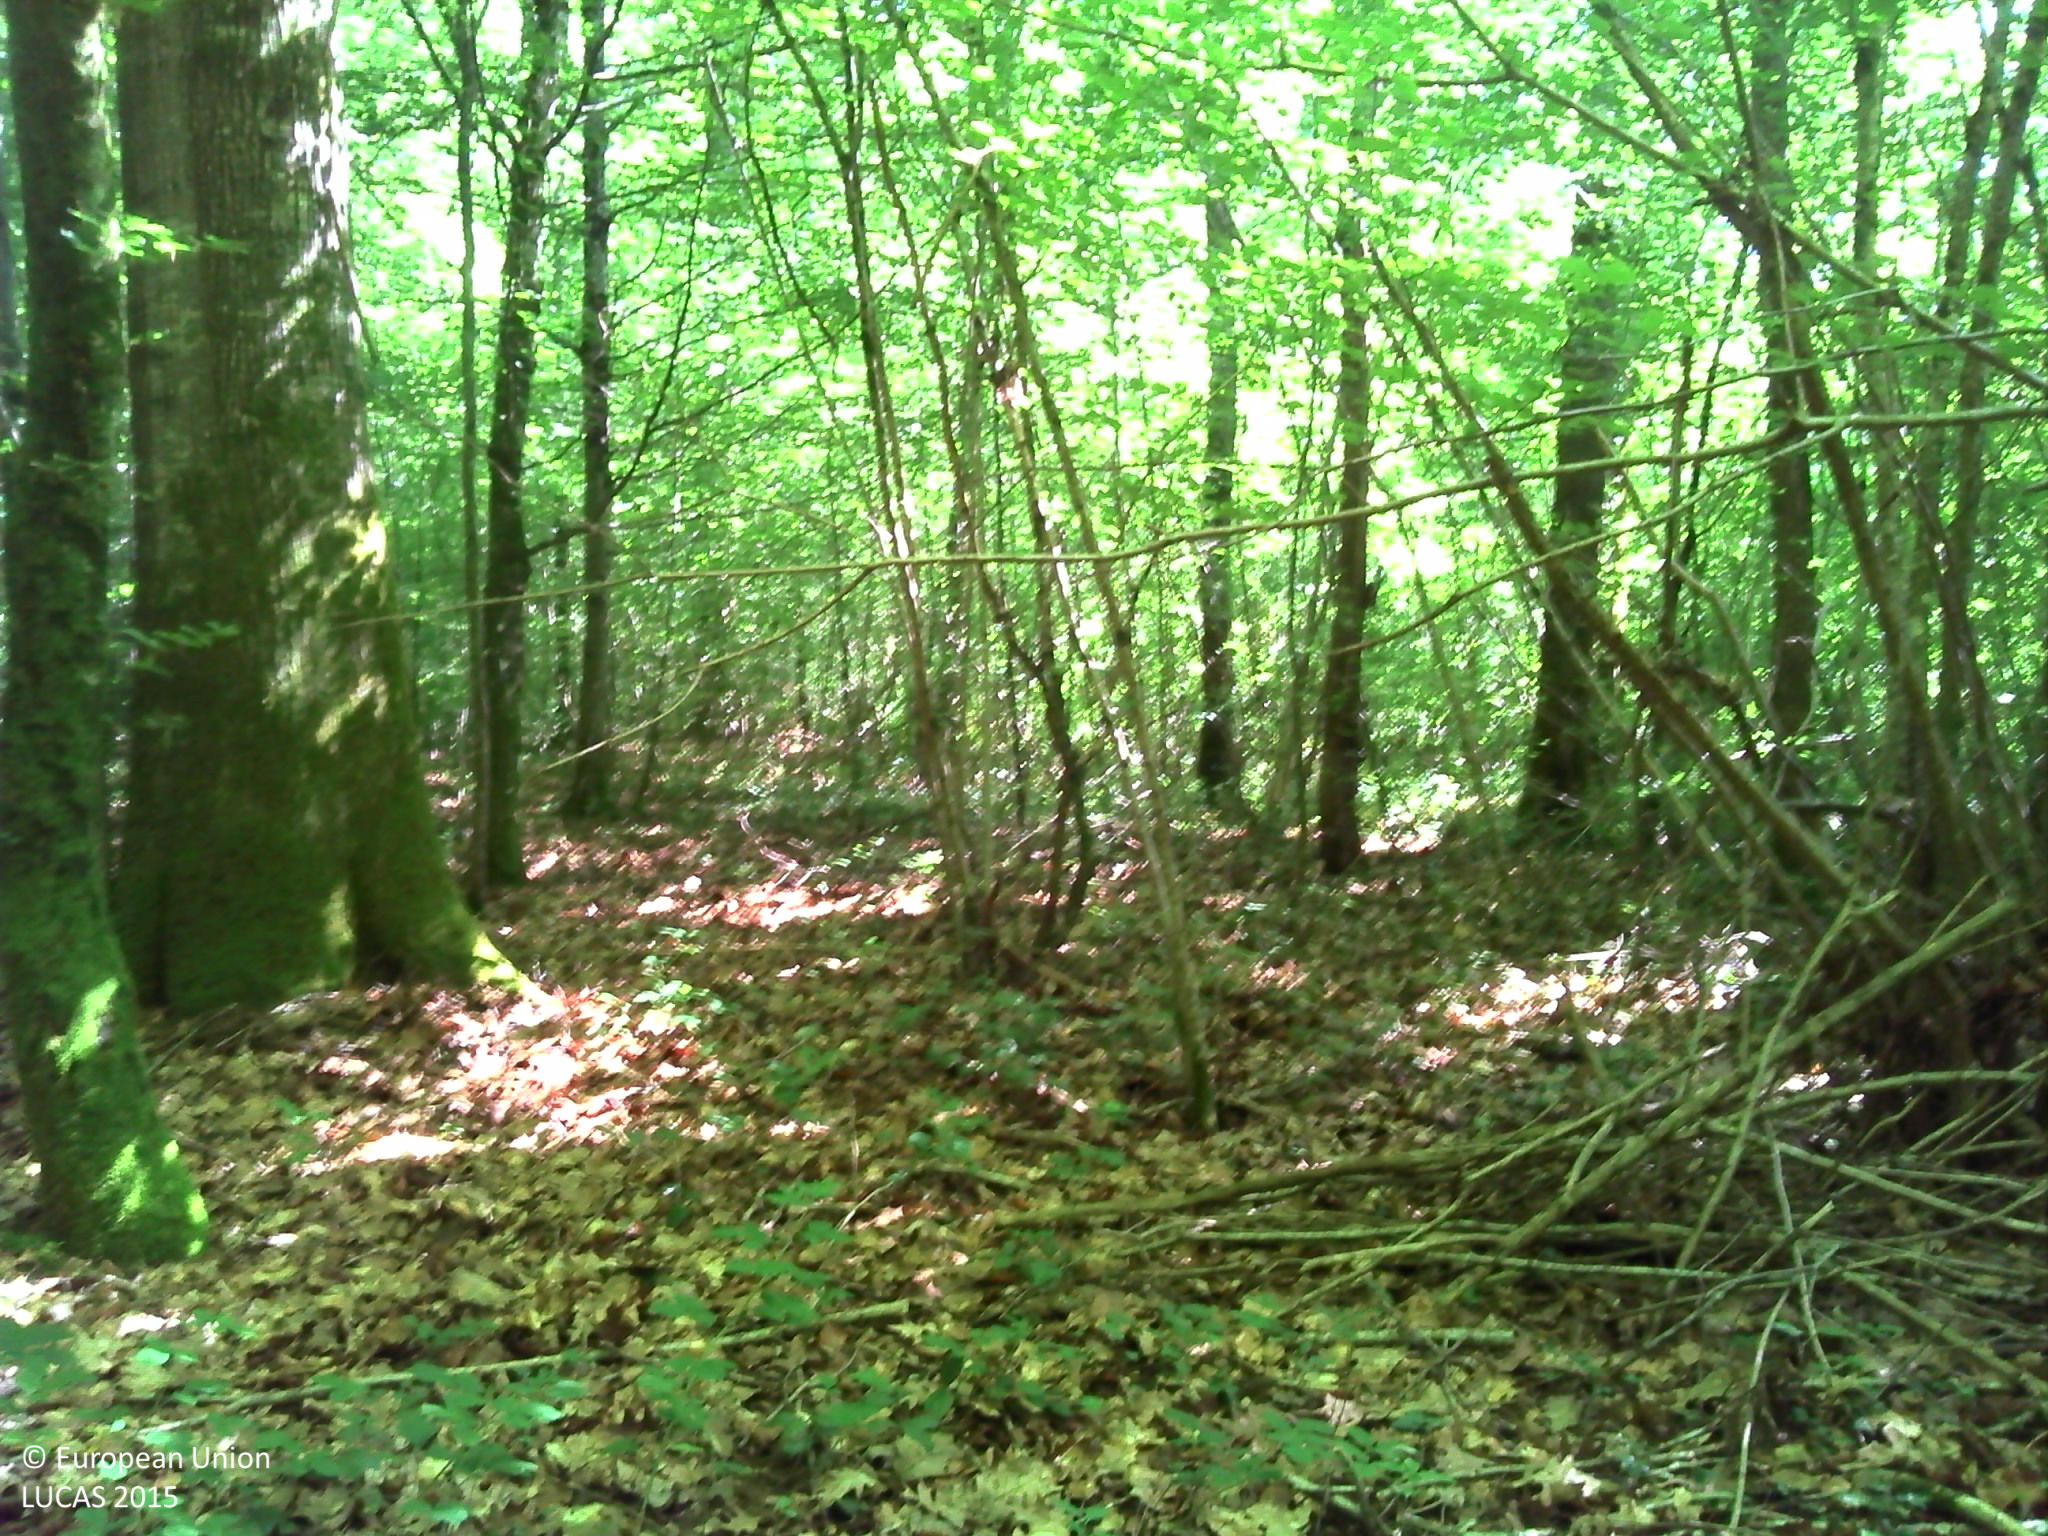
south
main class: Woodland
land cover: Broadleaved woodland
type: beech forest
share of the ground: > 75 %
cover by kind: broadleaved forest trees 90 %, shrubs 5 %, herbaceous plants 5 %
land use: Forestry
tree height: > 5 m
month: June
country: FR
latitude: 47.5073
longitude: 6.1378
